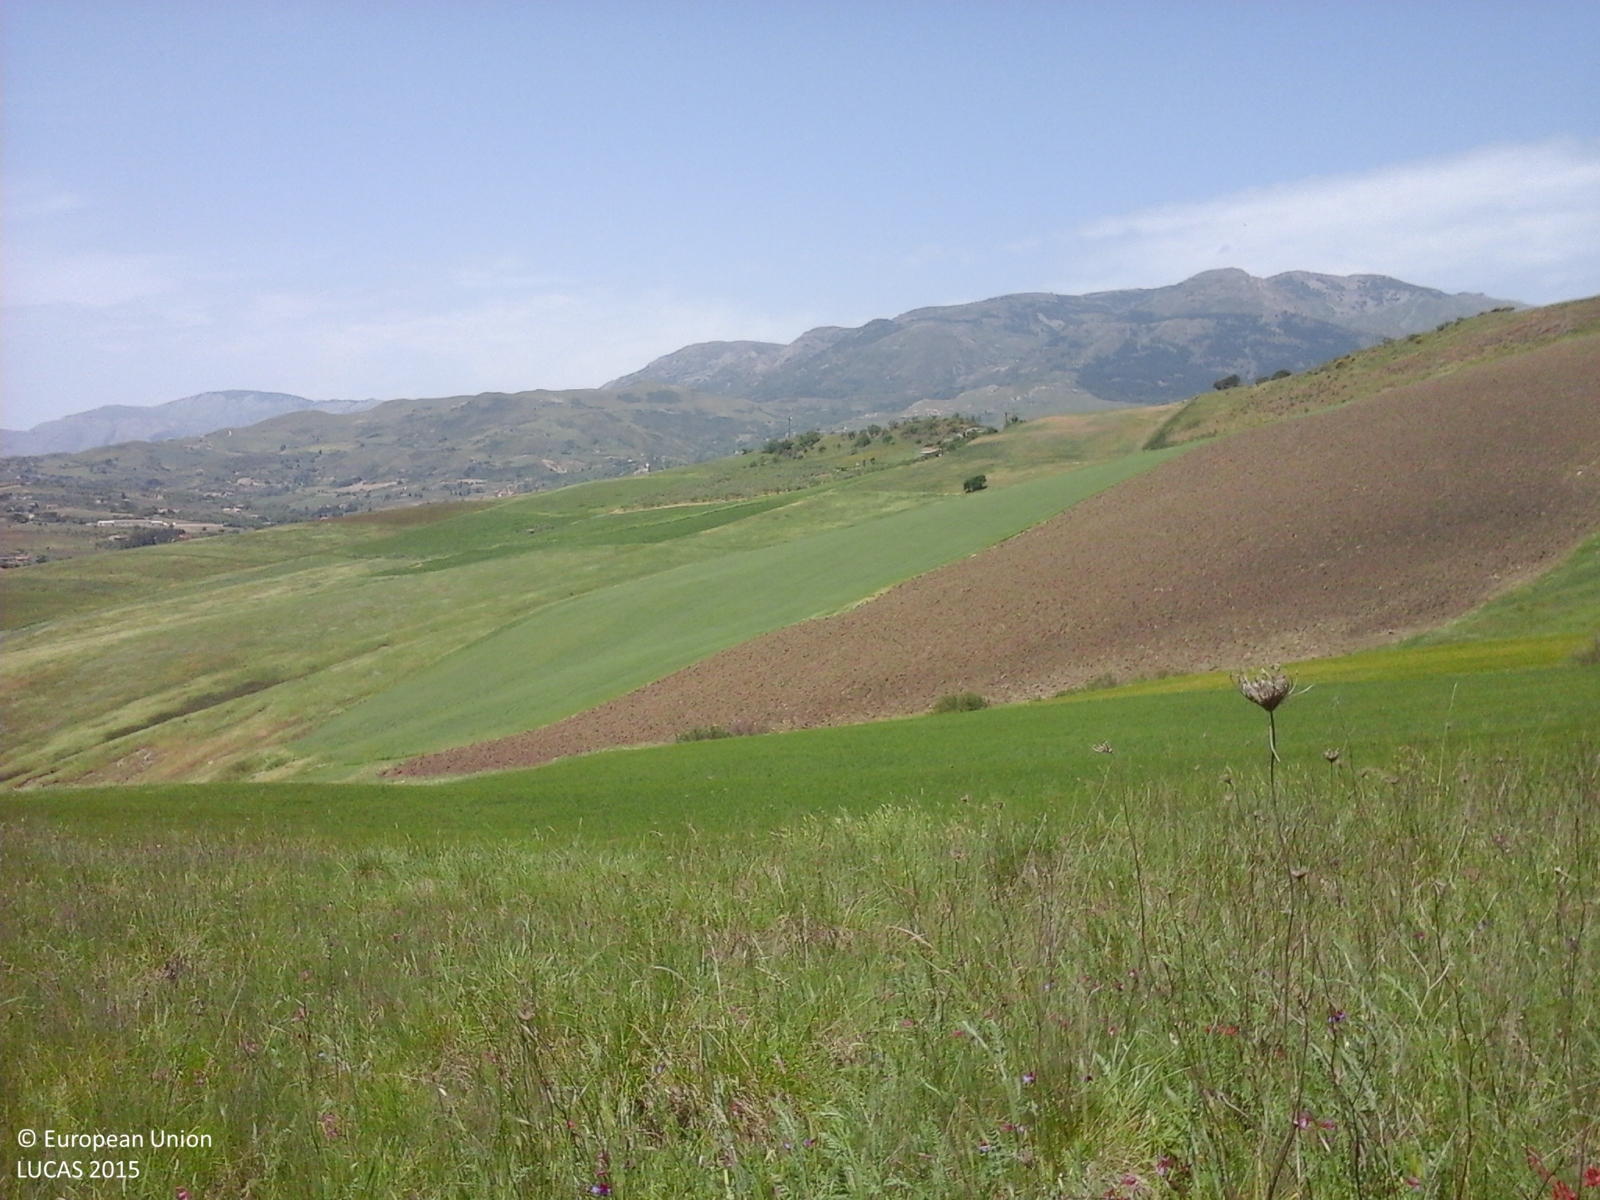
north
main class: Grassland
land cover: Spontaneously vegetated surfaces
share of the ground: > 75 %
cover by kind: herbaceous plants 100 %
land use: Fallow land
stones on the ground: < 10 %
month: May
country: IT
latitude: 37.7704
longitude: 14.0465
